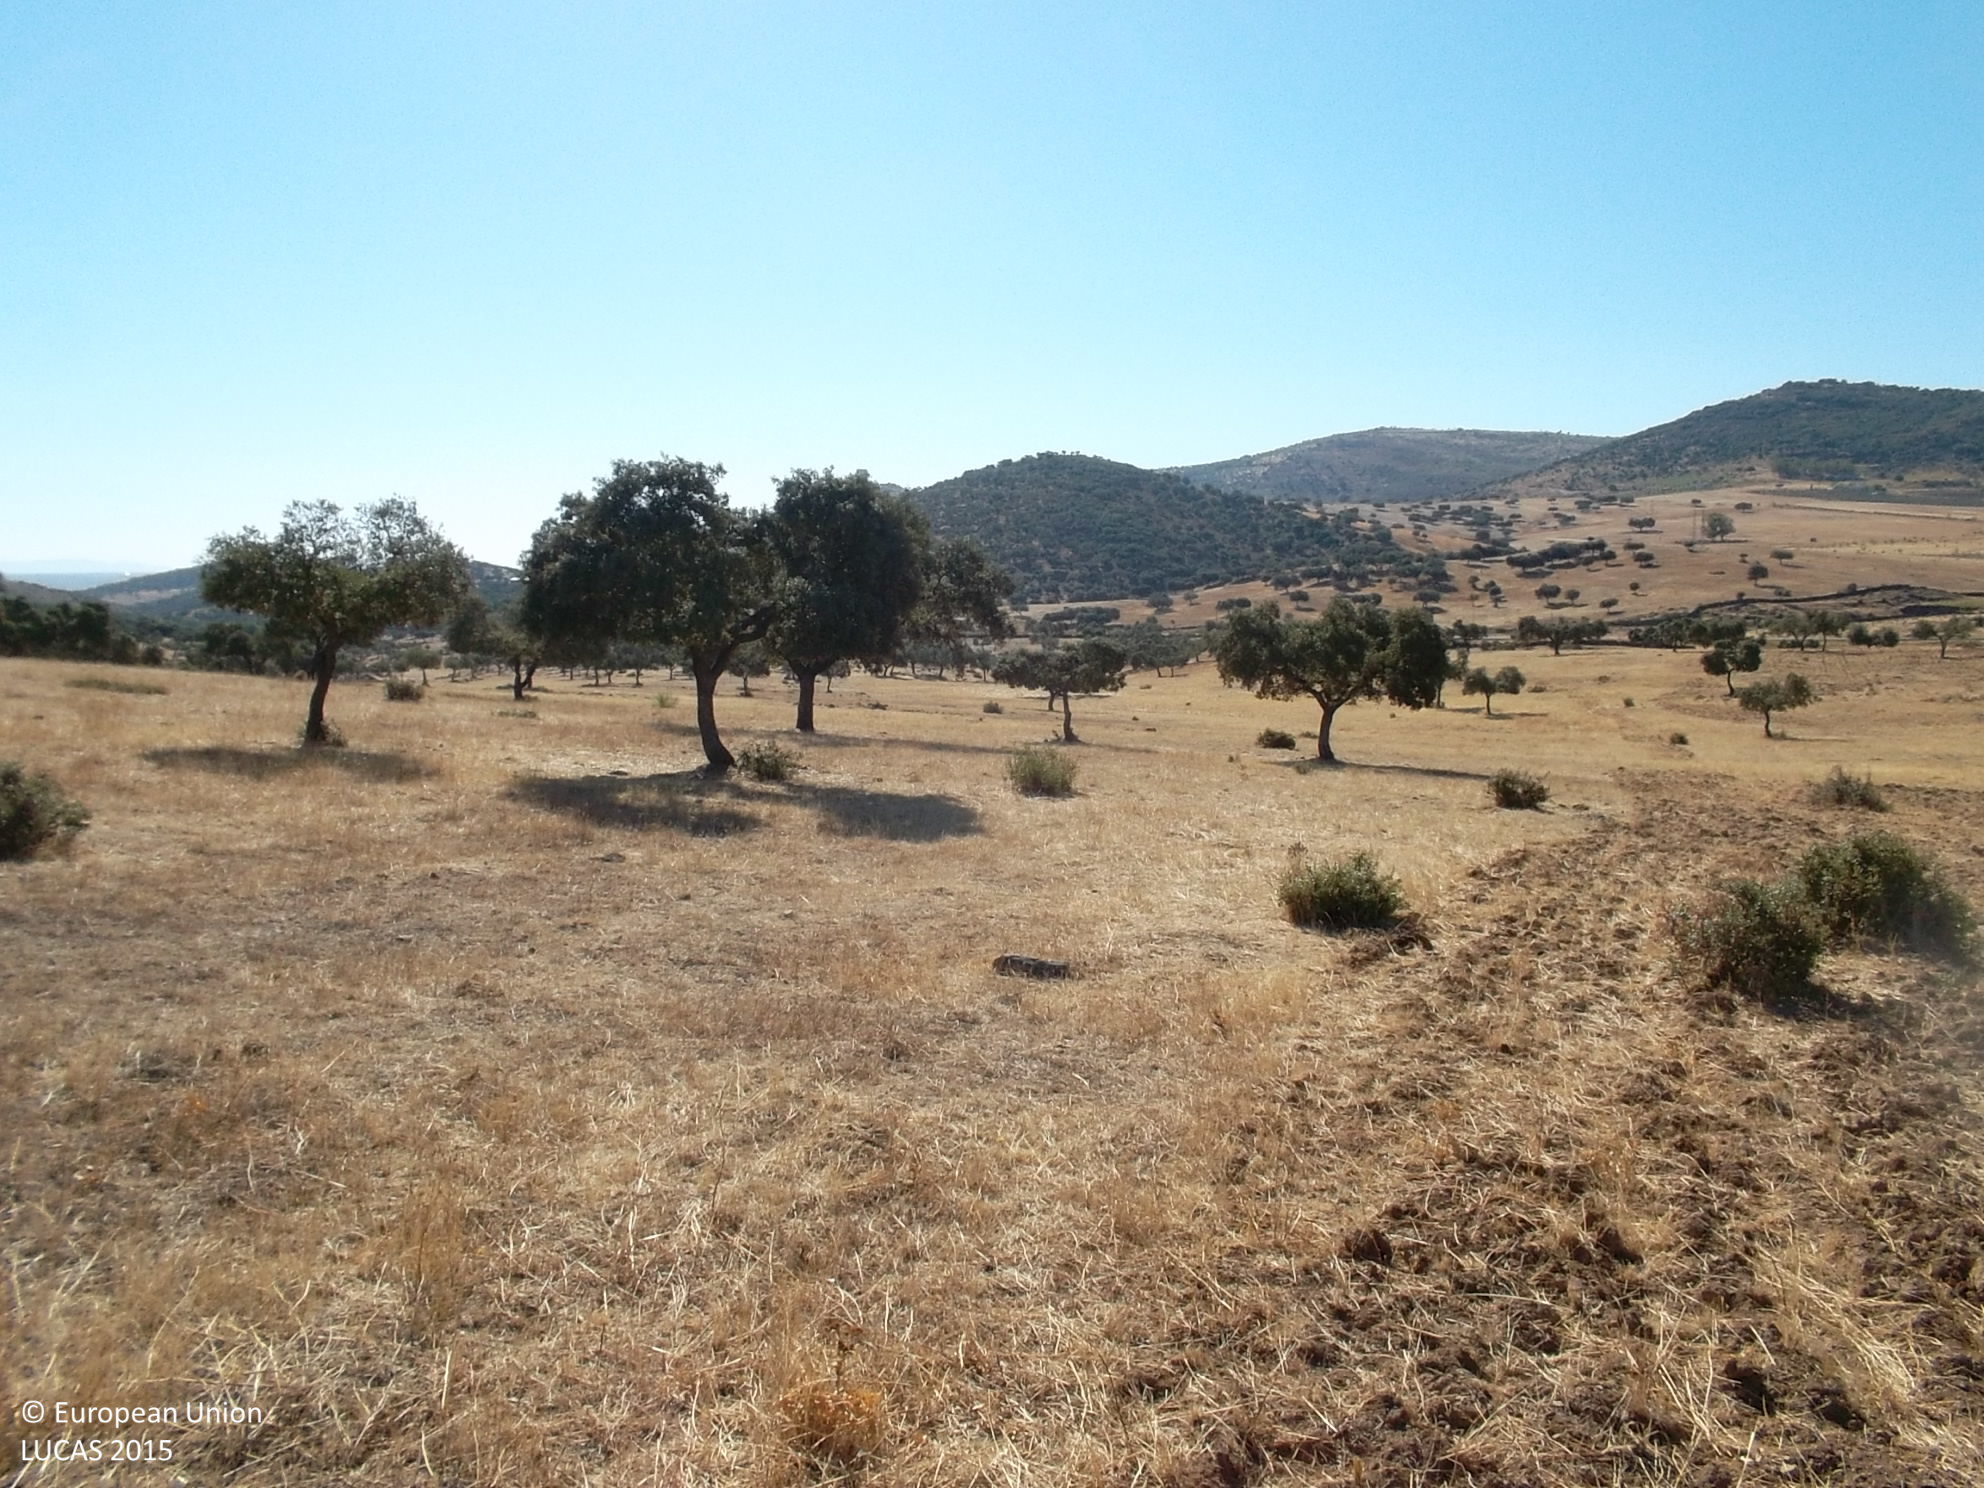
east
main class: Woodland
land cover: Broadleaved woodland
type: broadleaved evergreen forest
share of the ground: 10 - 25 %
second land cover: Grassland without tree/shrub cover
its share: > 75 %
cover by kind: herbaceous plants 85 %, broadleaved forest trees 10 %, shrubs 5 %
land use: Forestry
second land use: Agriculture (excluding fallow land and kitchen gardens)
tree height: < 5 m
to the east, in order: Broadleaved woodland; Grassland without tree/shrub cover; Broadleaved woodland; Grassland with sparse tree/shrub cover
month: August
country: ES
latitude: 38.5272
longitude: -6.6082
